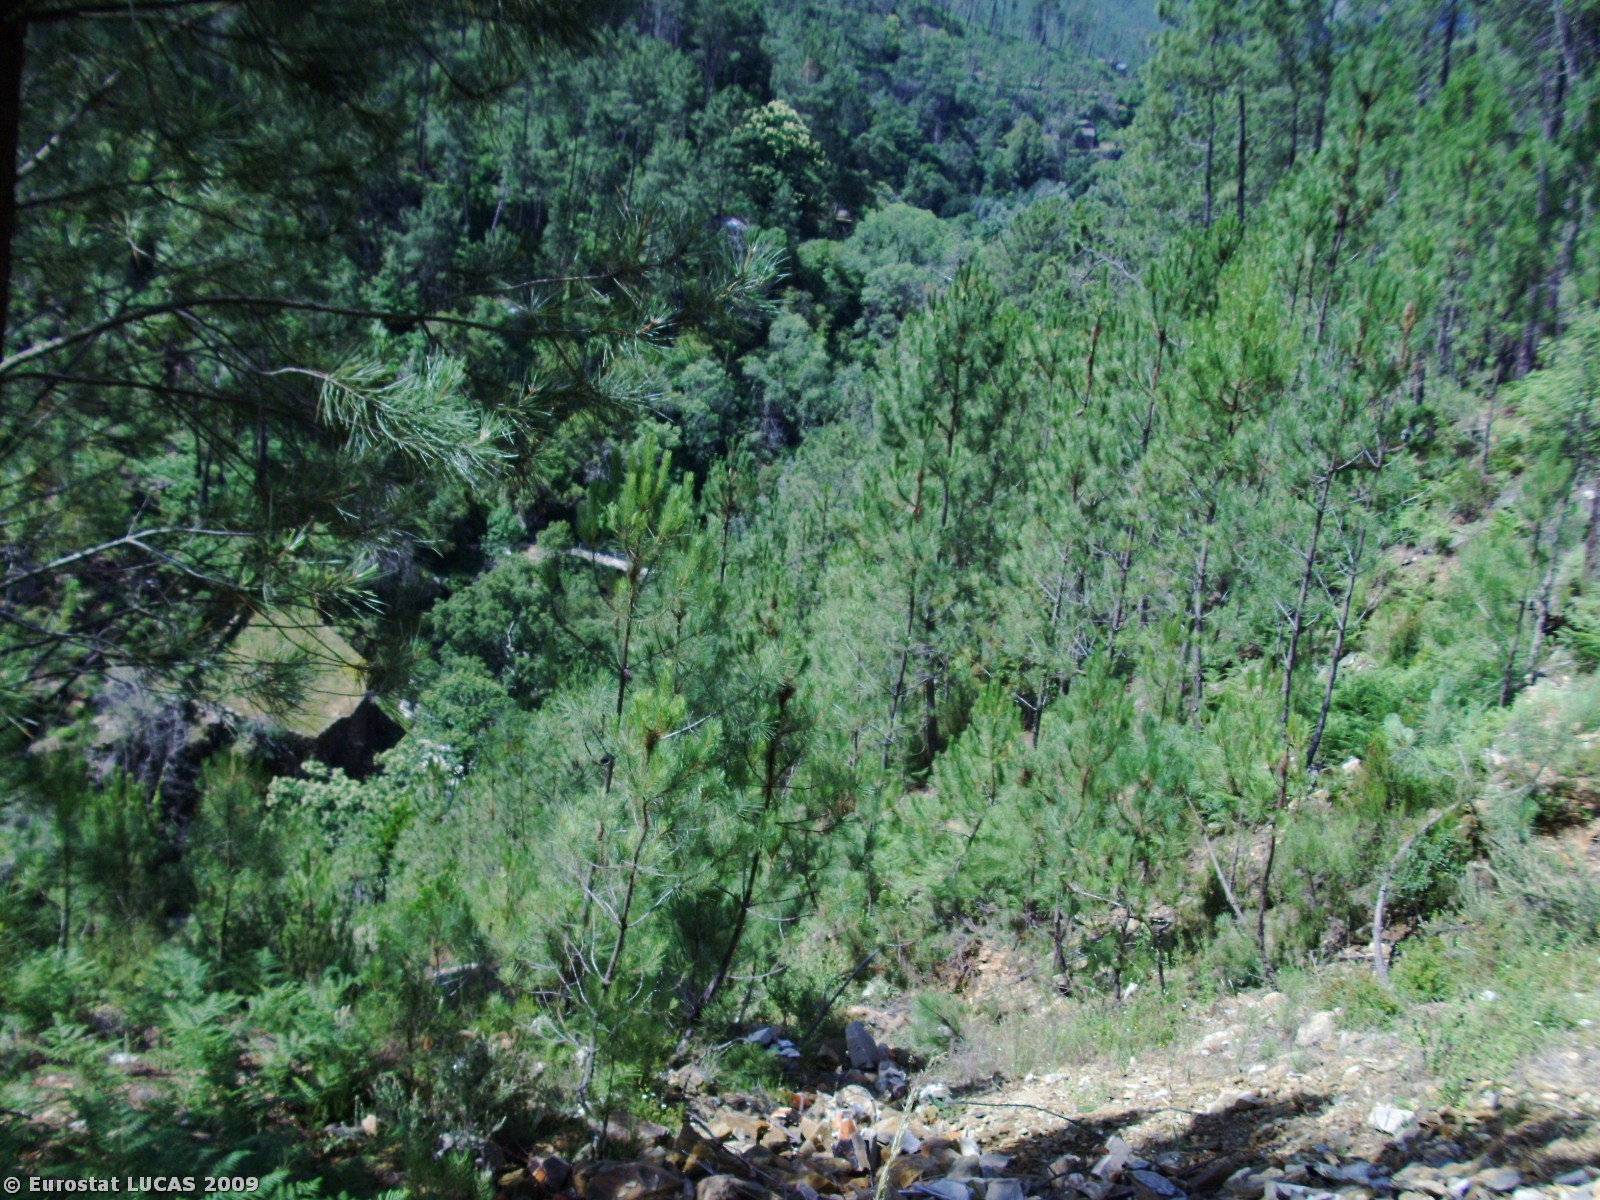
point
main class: Woodland
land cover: Coniferous woodland
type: coniferous forest of the mediterranean region
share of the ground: 50 - 75 %
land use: Forestry
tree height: > 5 m
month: June
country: PT
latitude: 40.3183
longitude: -7.7305
